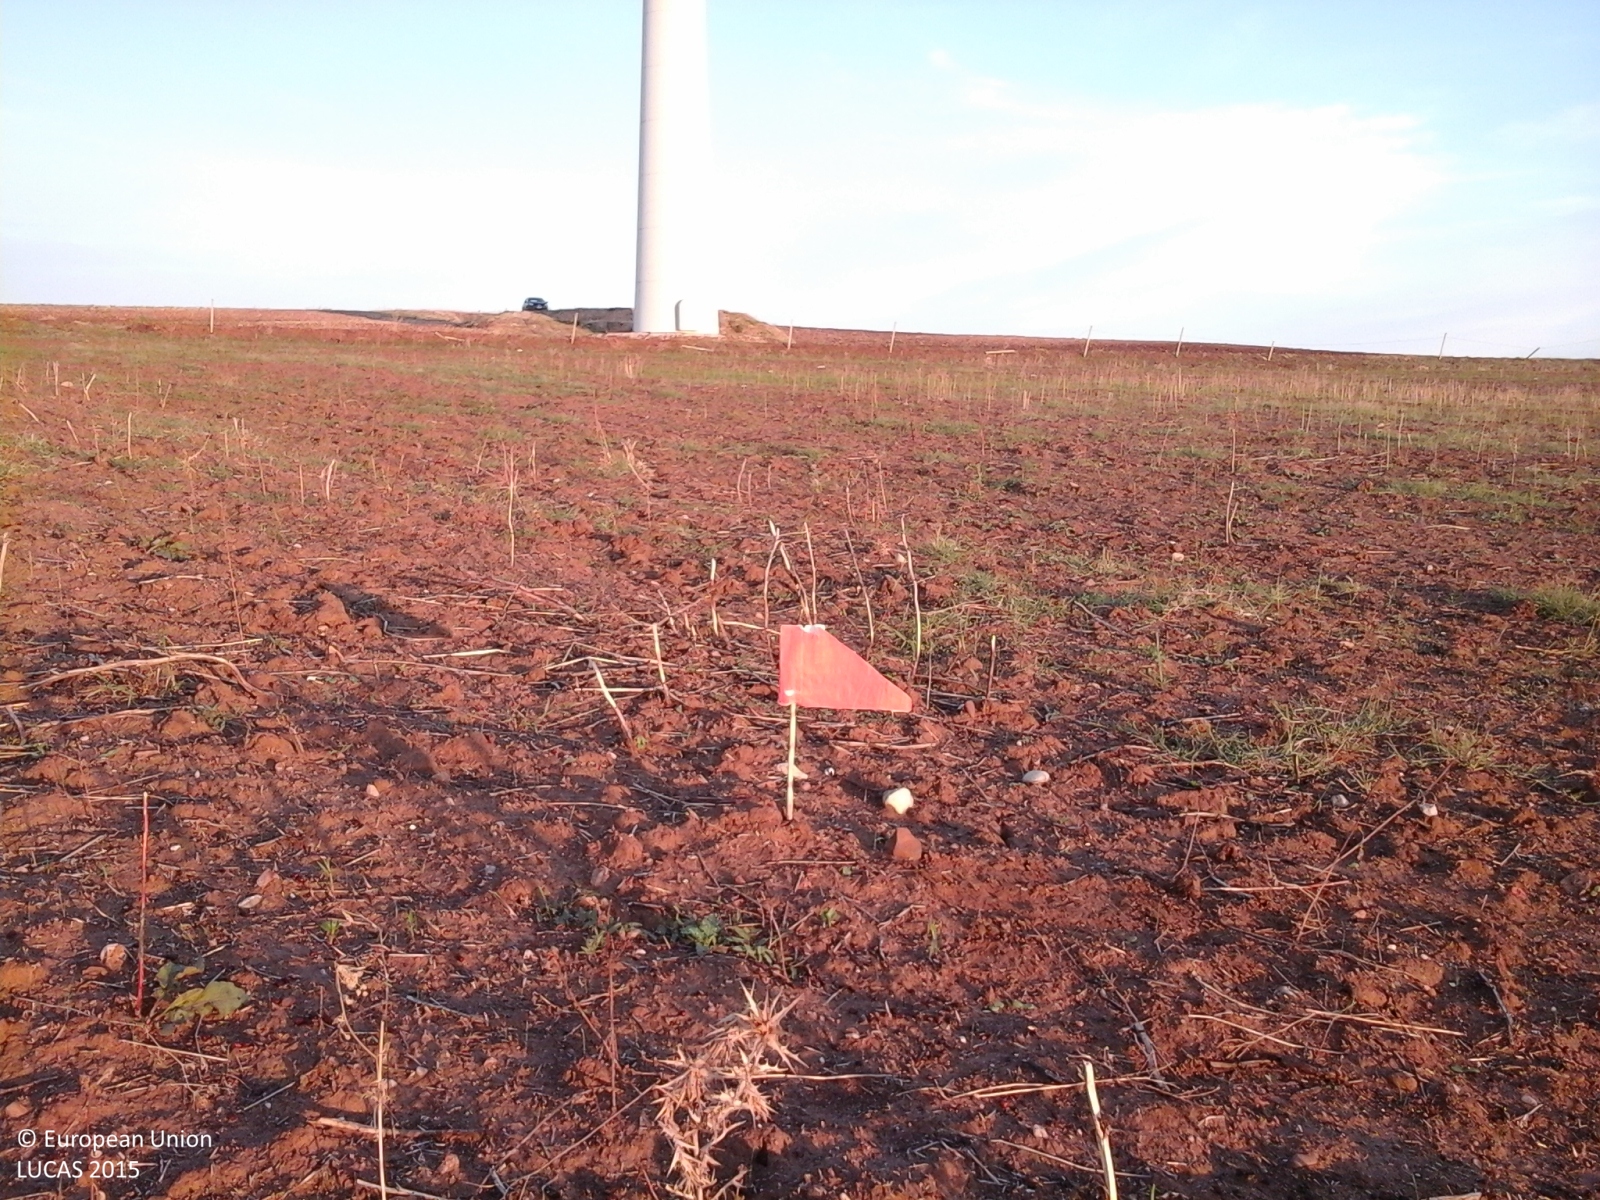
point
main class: Cropland
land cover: Dry pulses
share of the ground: > 75 %
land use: Agriculture (excluding fallow land and kitchen gardens)
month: October
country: IT
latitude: 41.8856
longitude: 15.2264
